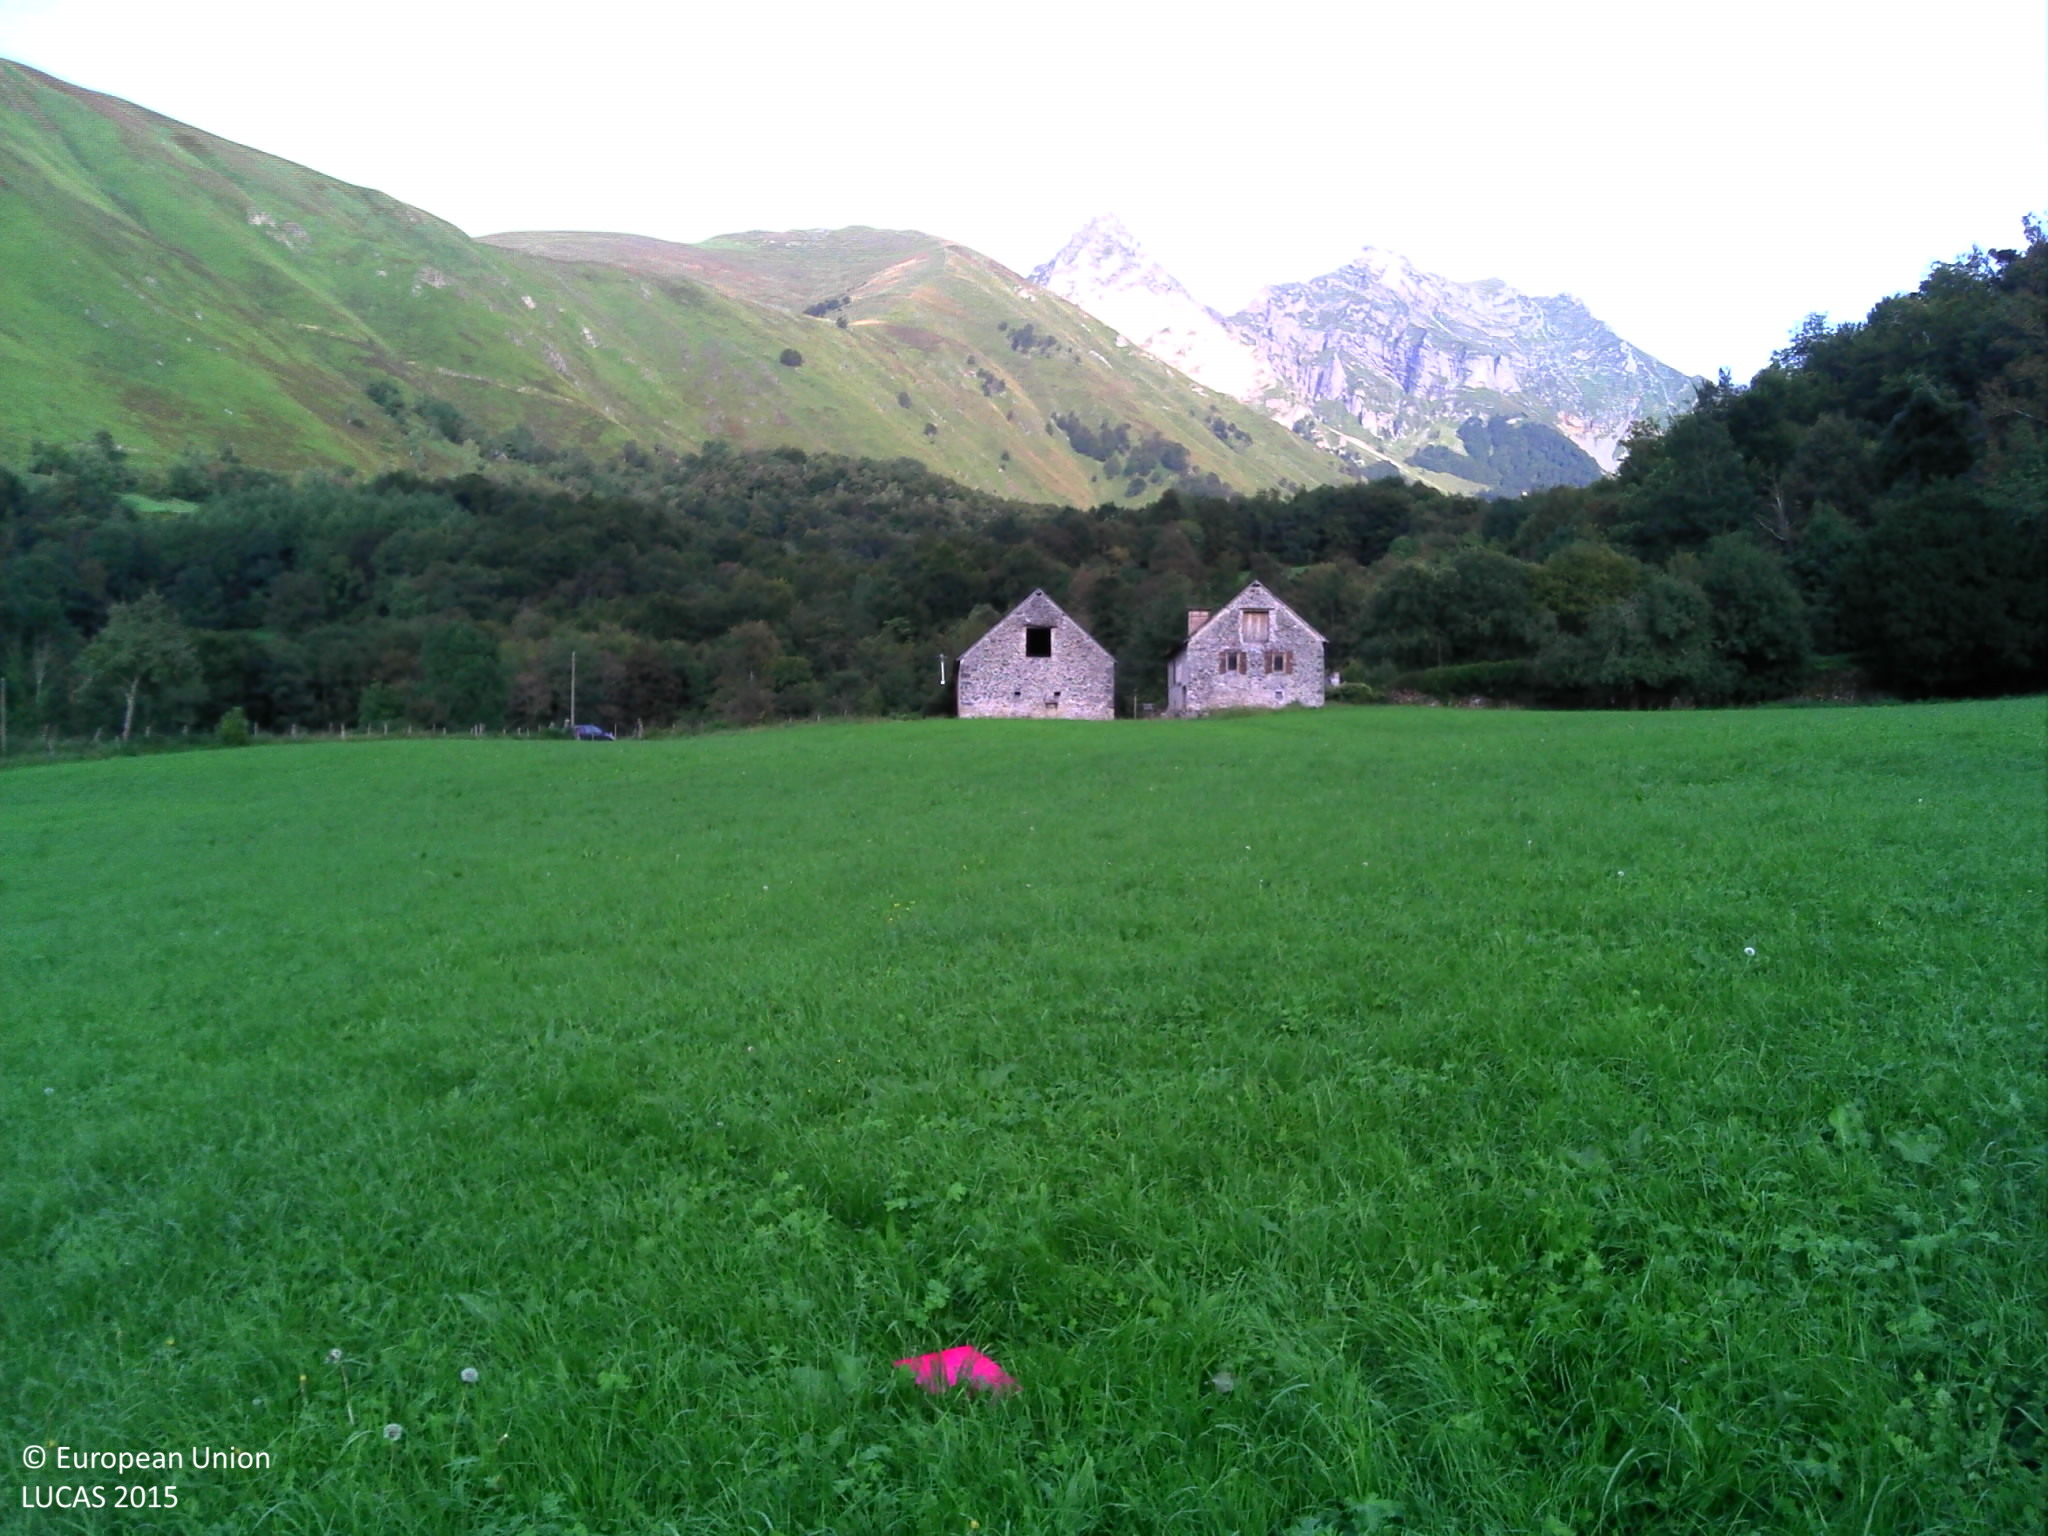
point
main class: Grassland
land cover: Grassland without tree/shrub cover
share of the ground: > 75 %
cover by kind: herbaceous plants 100 %
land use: Agriculture (excluding fallow land and kitchen gardens)
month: September
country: FR
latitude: 42.9709
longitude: -0.5873
